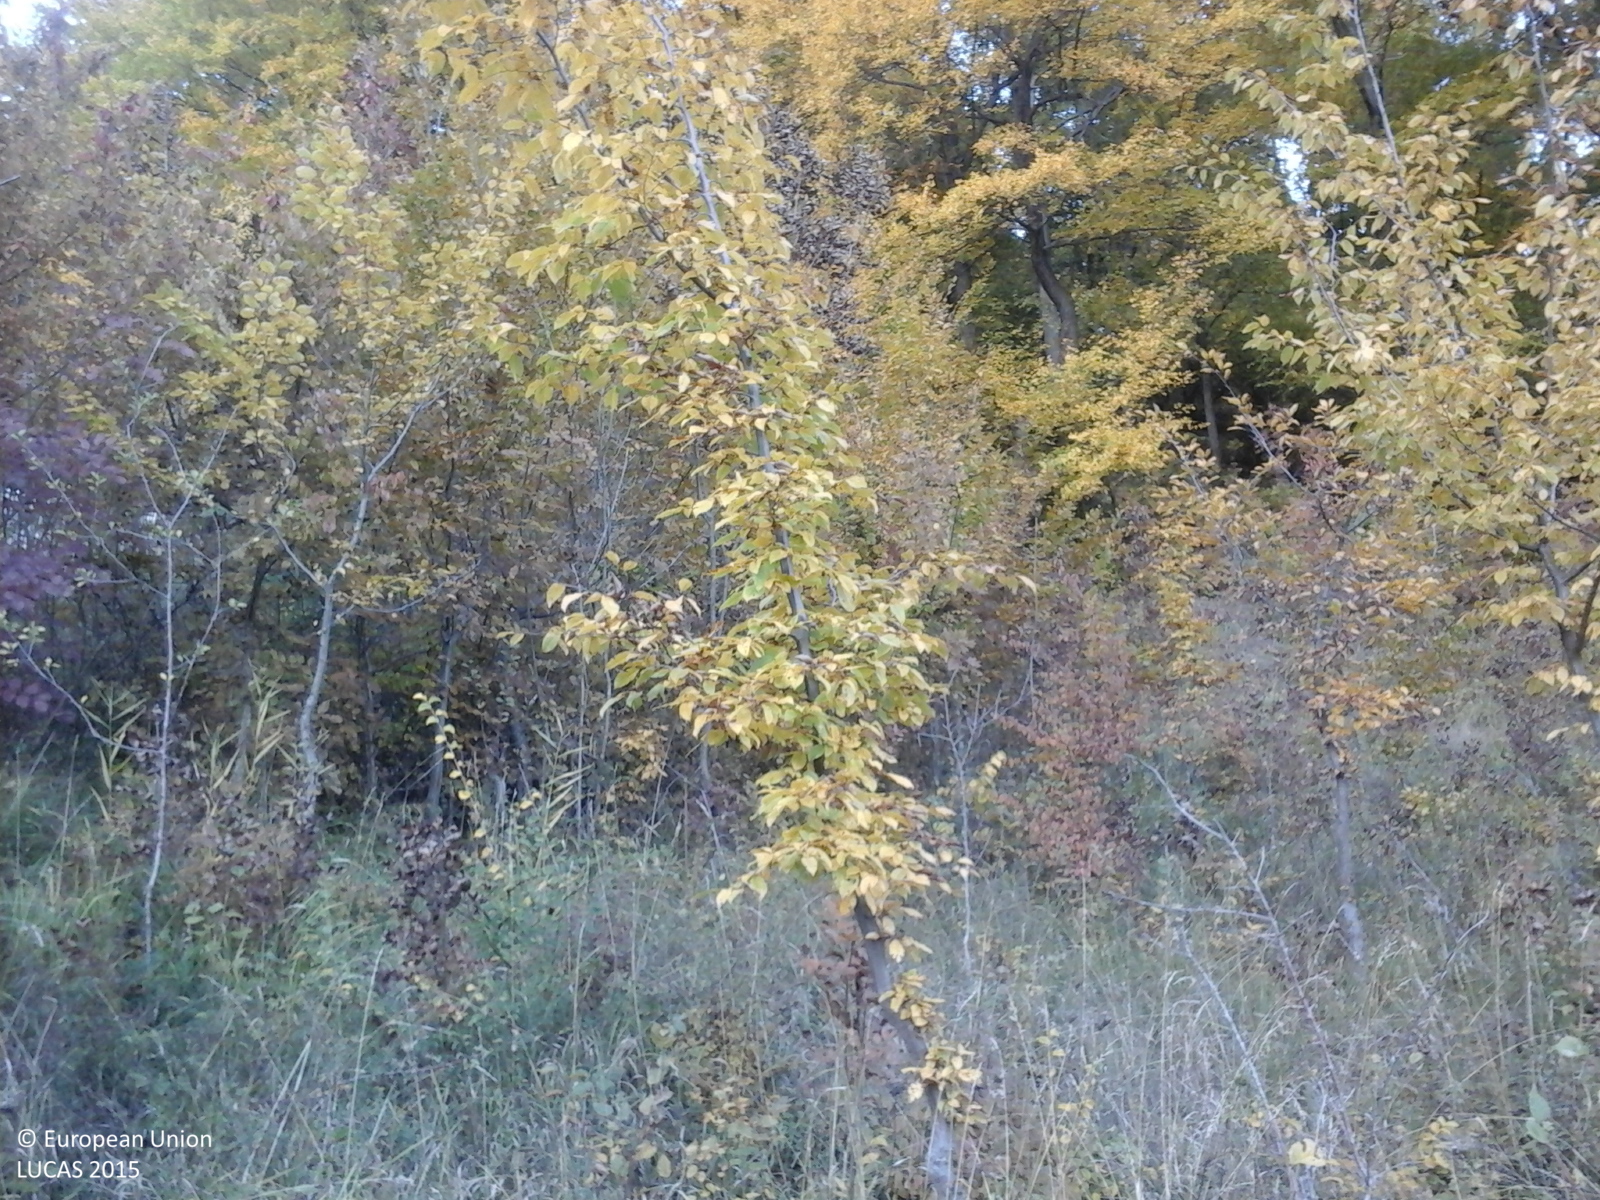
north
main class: Woodland
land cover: Broadleaved woodland
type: acidophilous oak and oak-birch forest
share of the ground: > 75 %
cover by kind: broadleaved forest trees 100 %
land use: Forestry
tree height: > 5 m
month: October
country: RO
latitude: 45.1967
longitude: 26.3227
